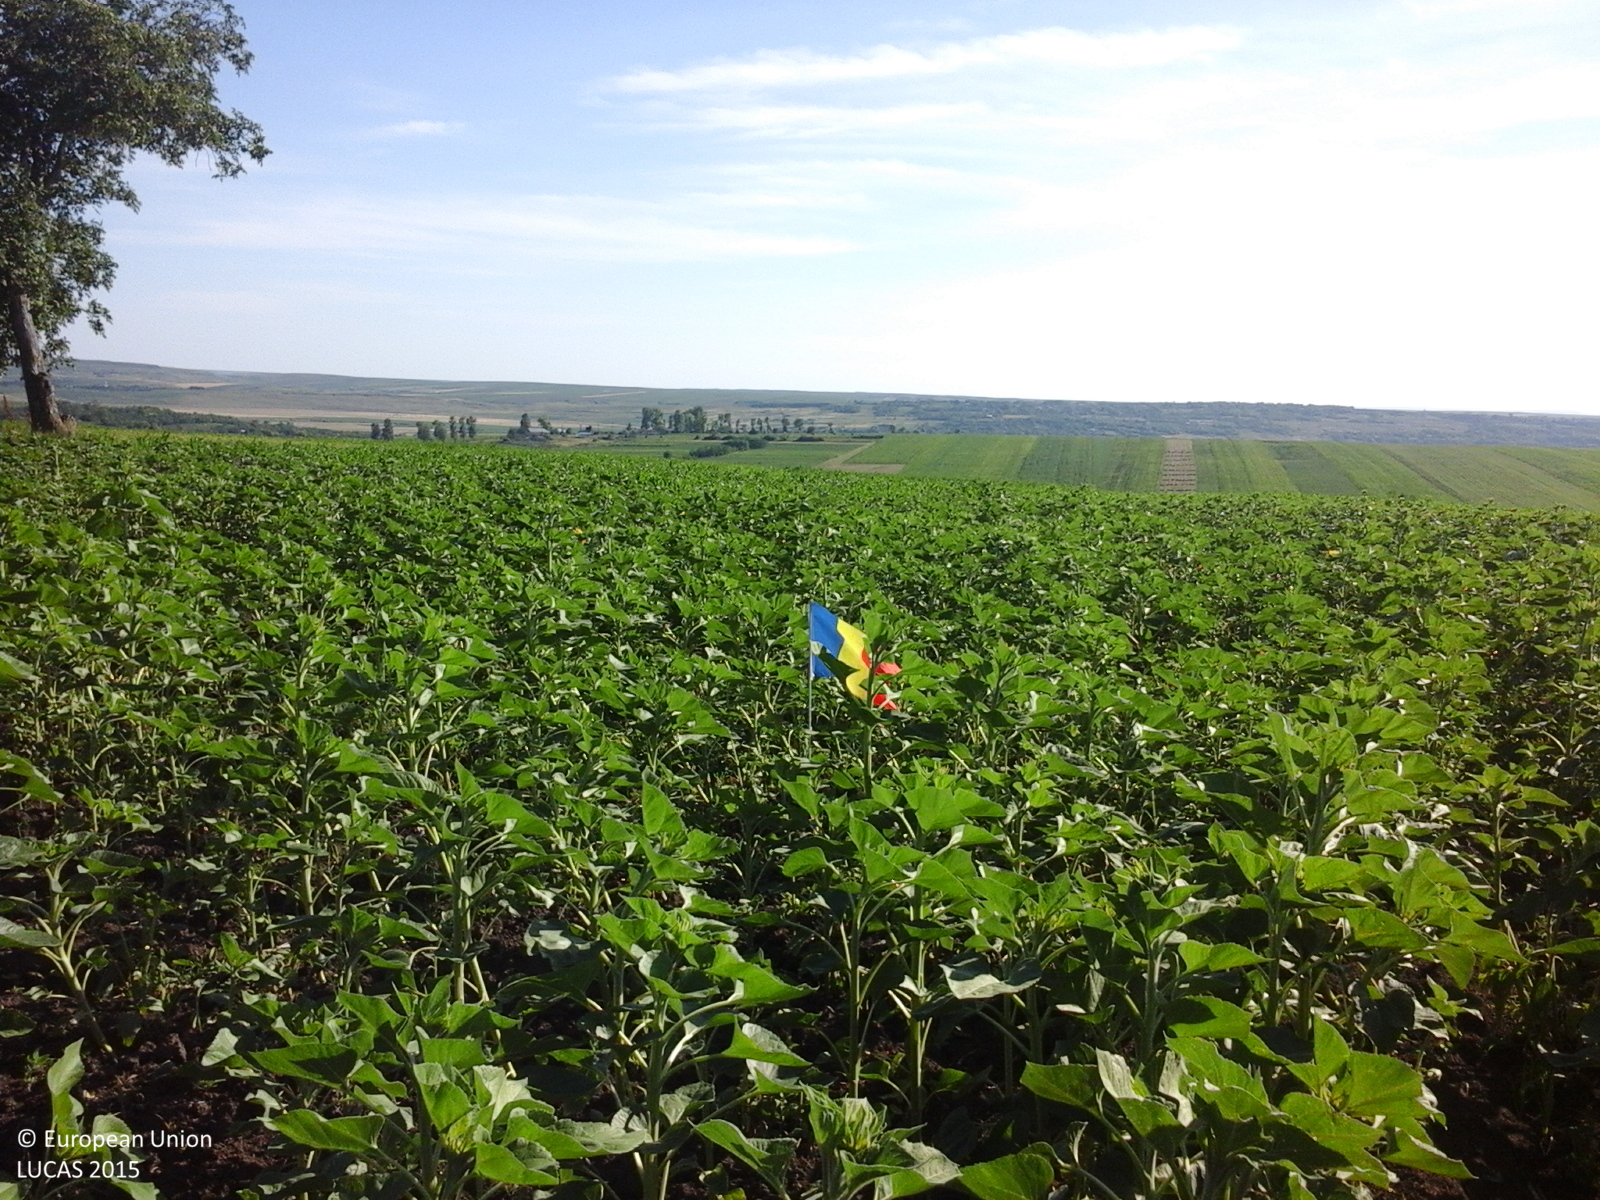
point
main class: Cropland
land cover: Sunflower
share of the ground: 50 - 75 %
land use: Agriculture (excluding fallow land and kitchen gardens)
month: June
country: RO
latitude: 47.4768
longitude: 27.2409
